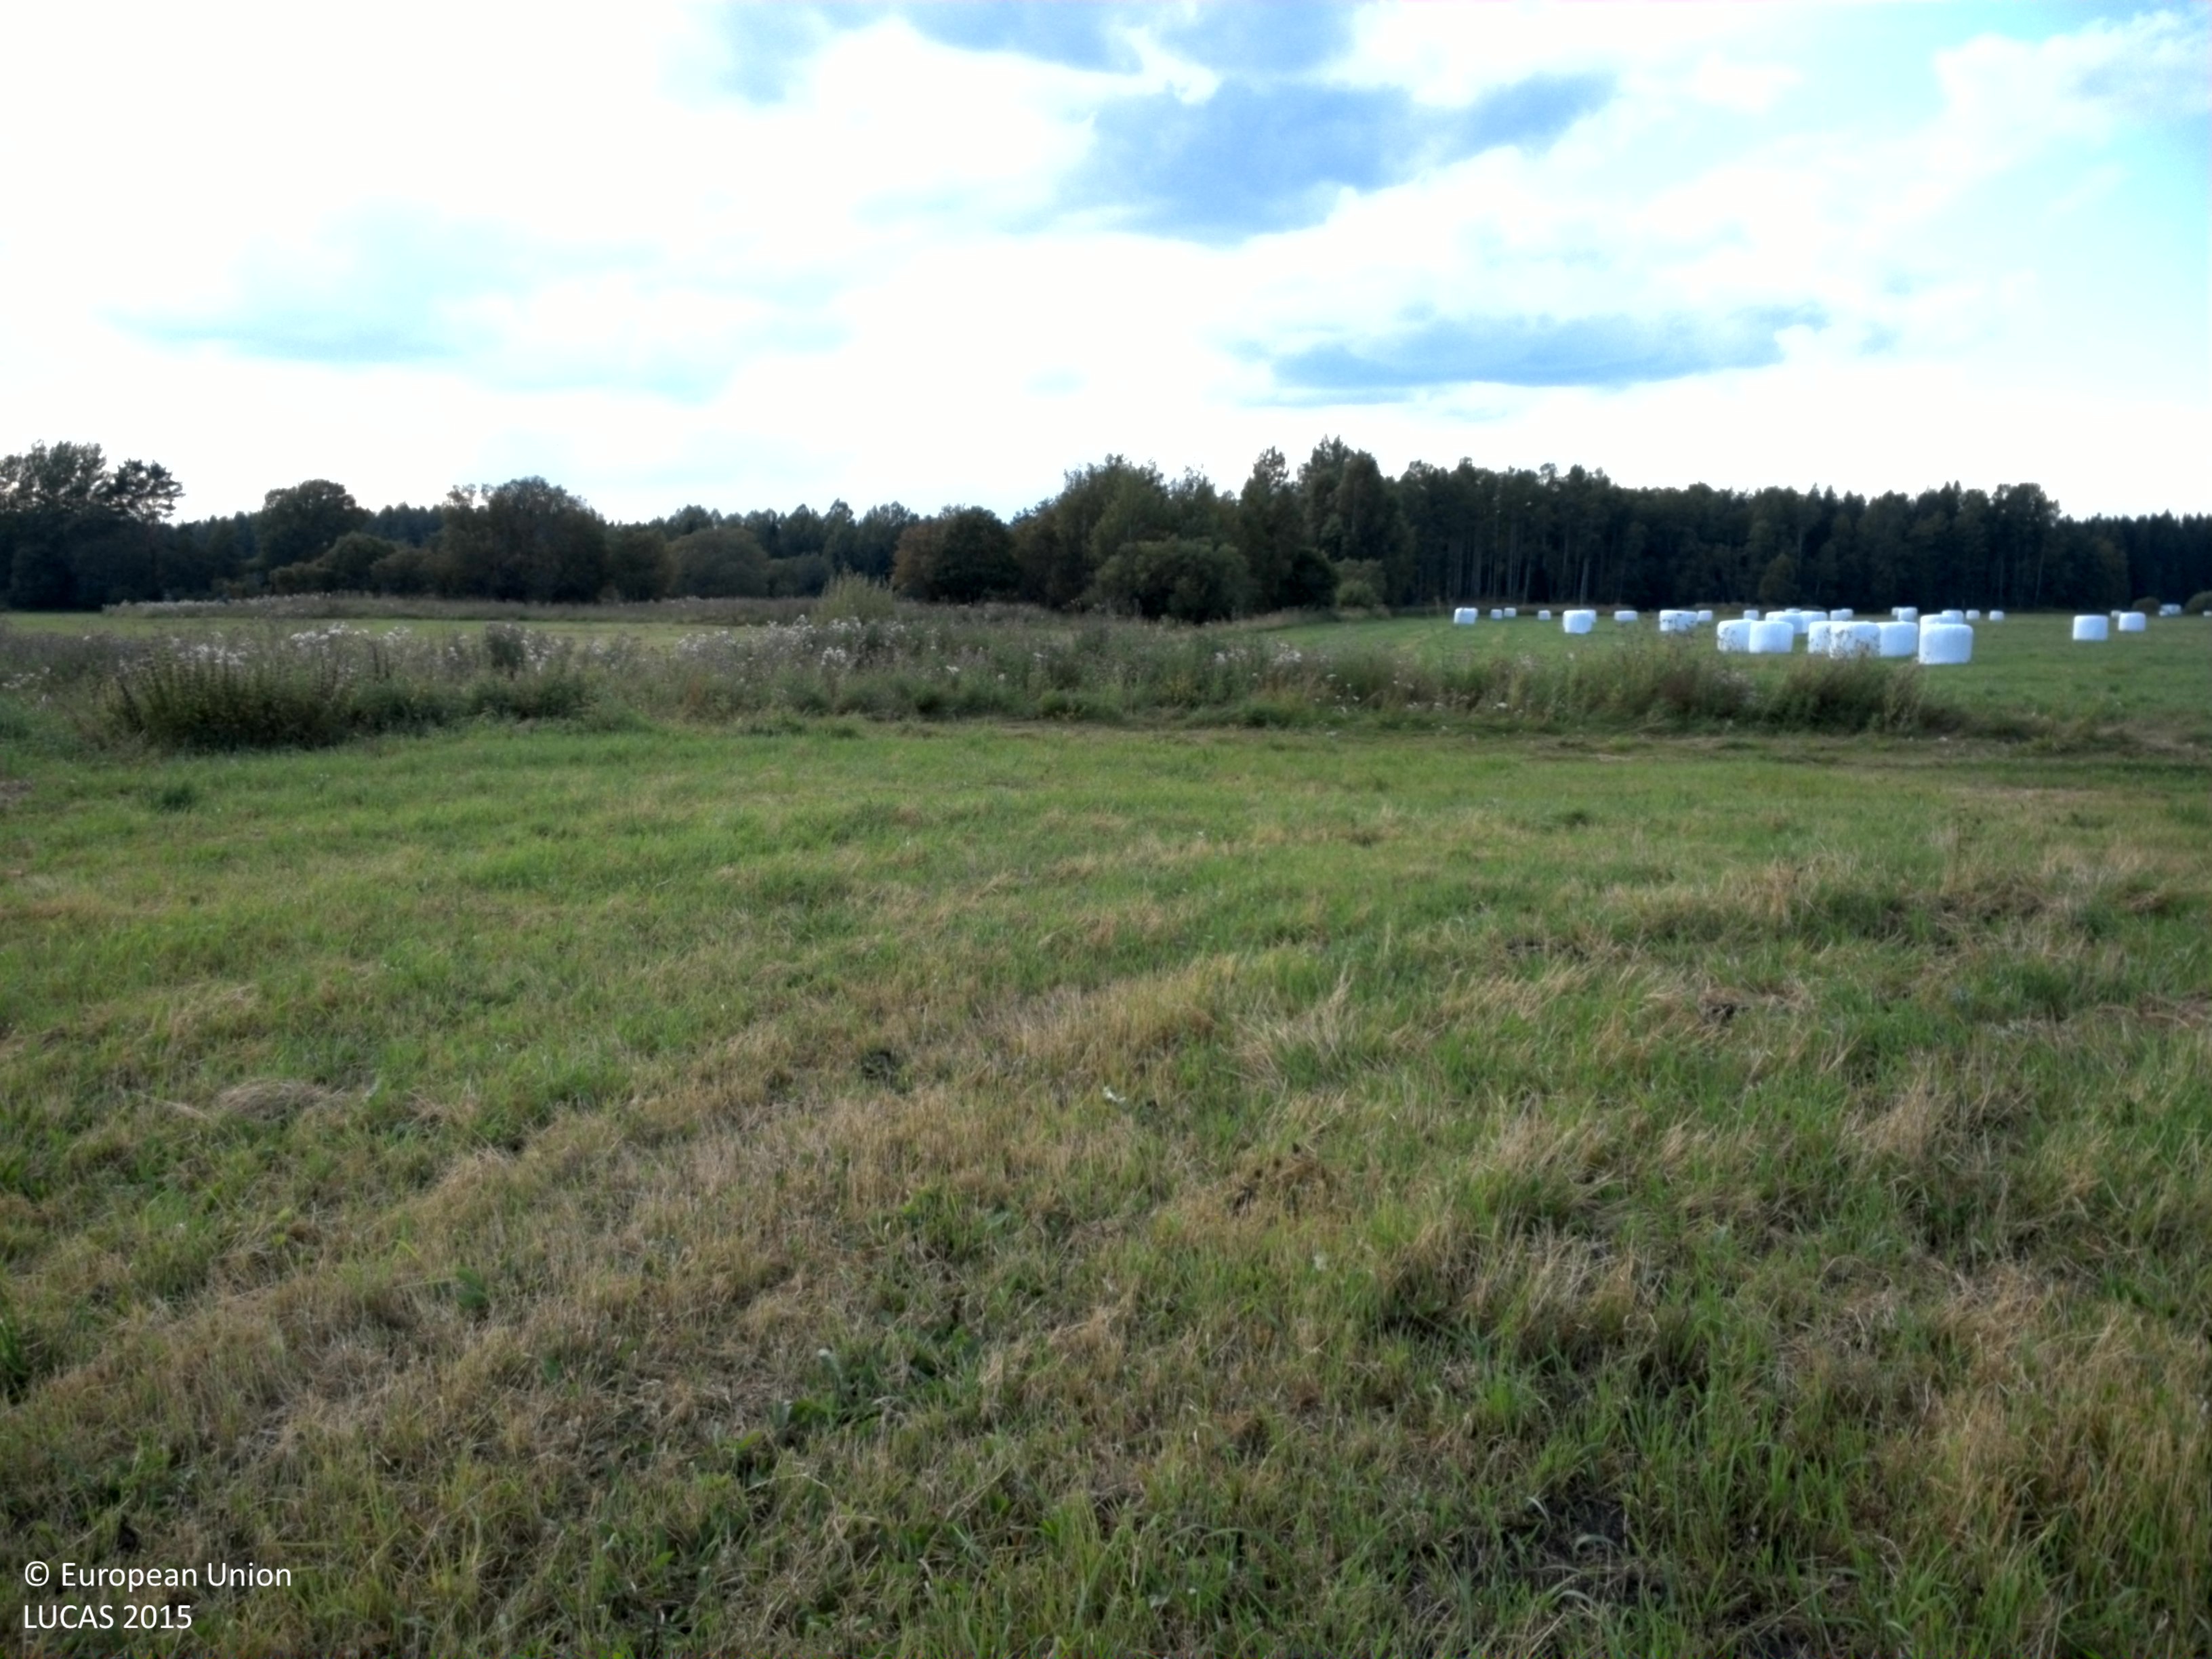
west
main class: Cropland
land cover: Other leguminous and mixtures for fodder
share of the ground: 25 - 50 %
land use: Agriculture (excluding fallow land and kitchen gardens)
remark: Harvested field
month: August
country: SE
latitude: 60.0607
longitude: 17.6998
